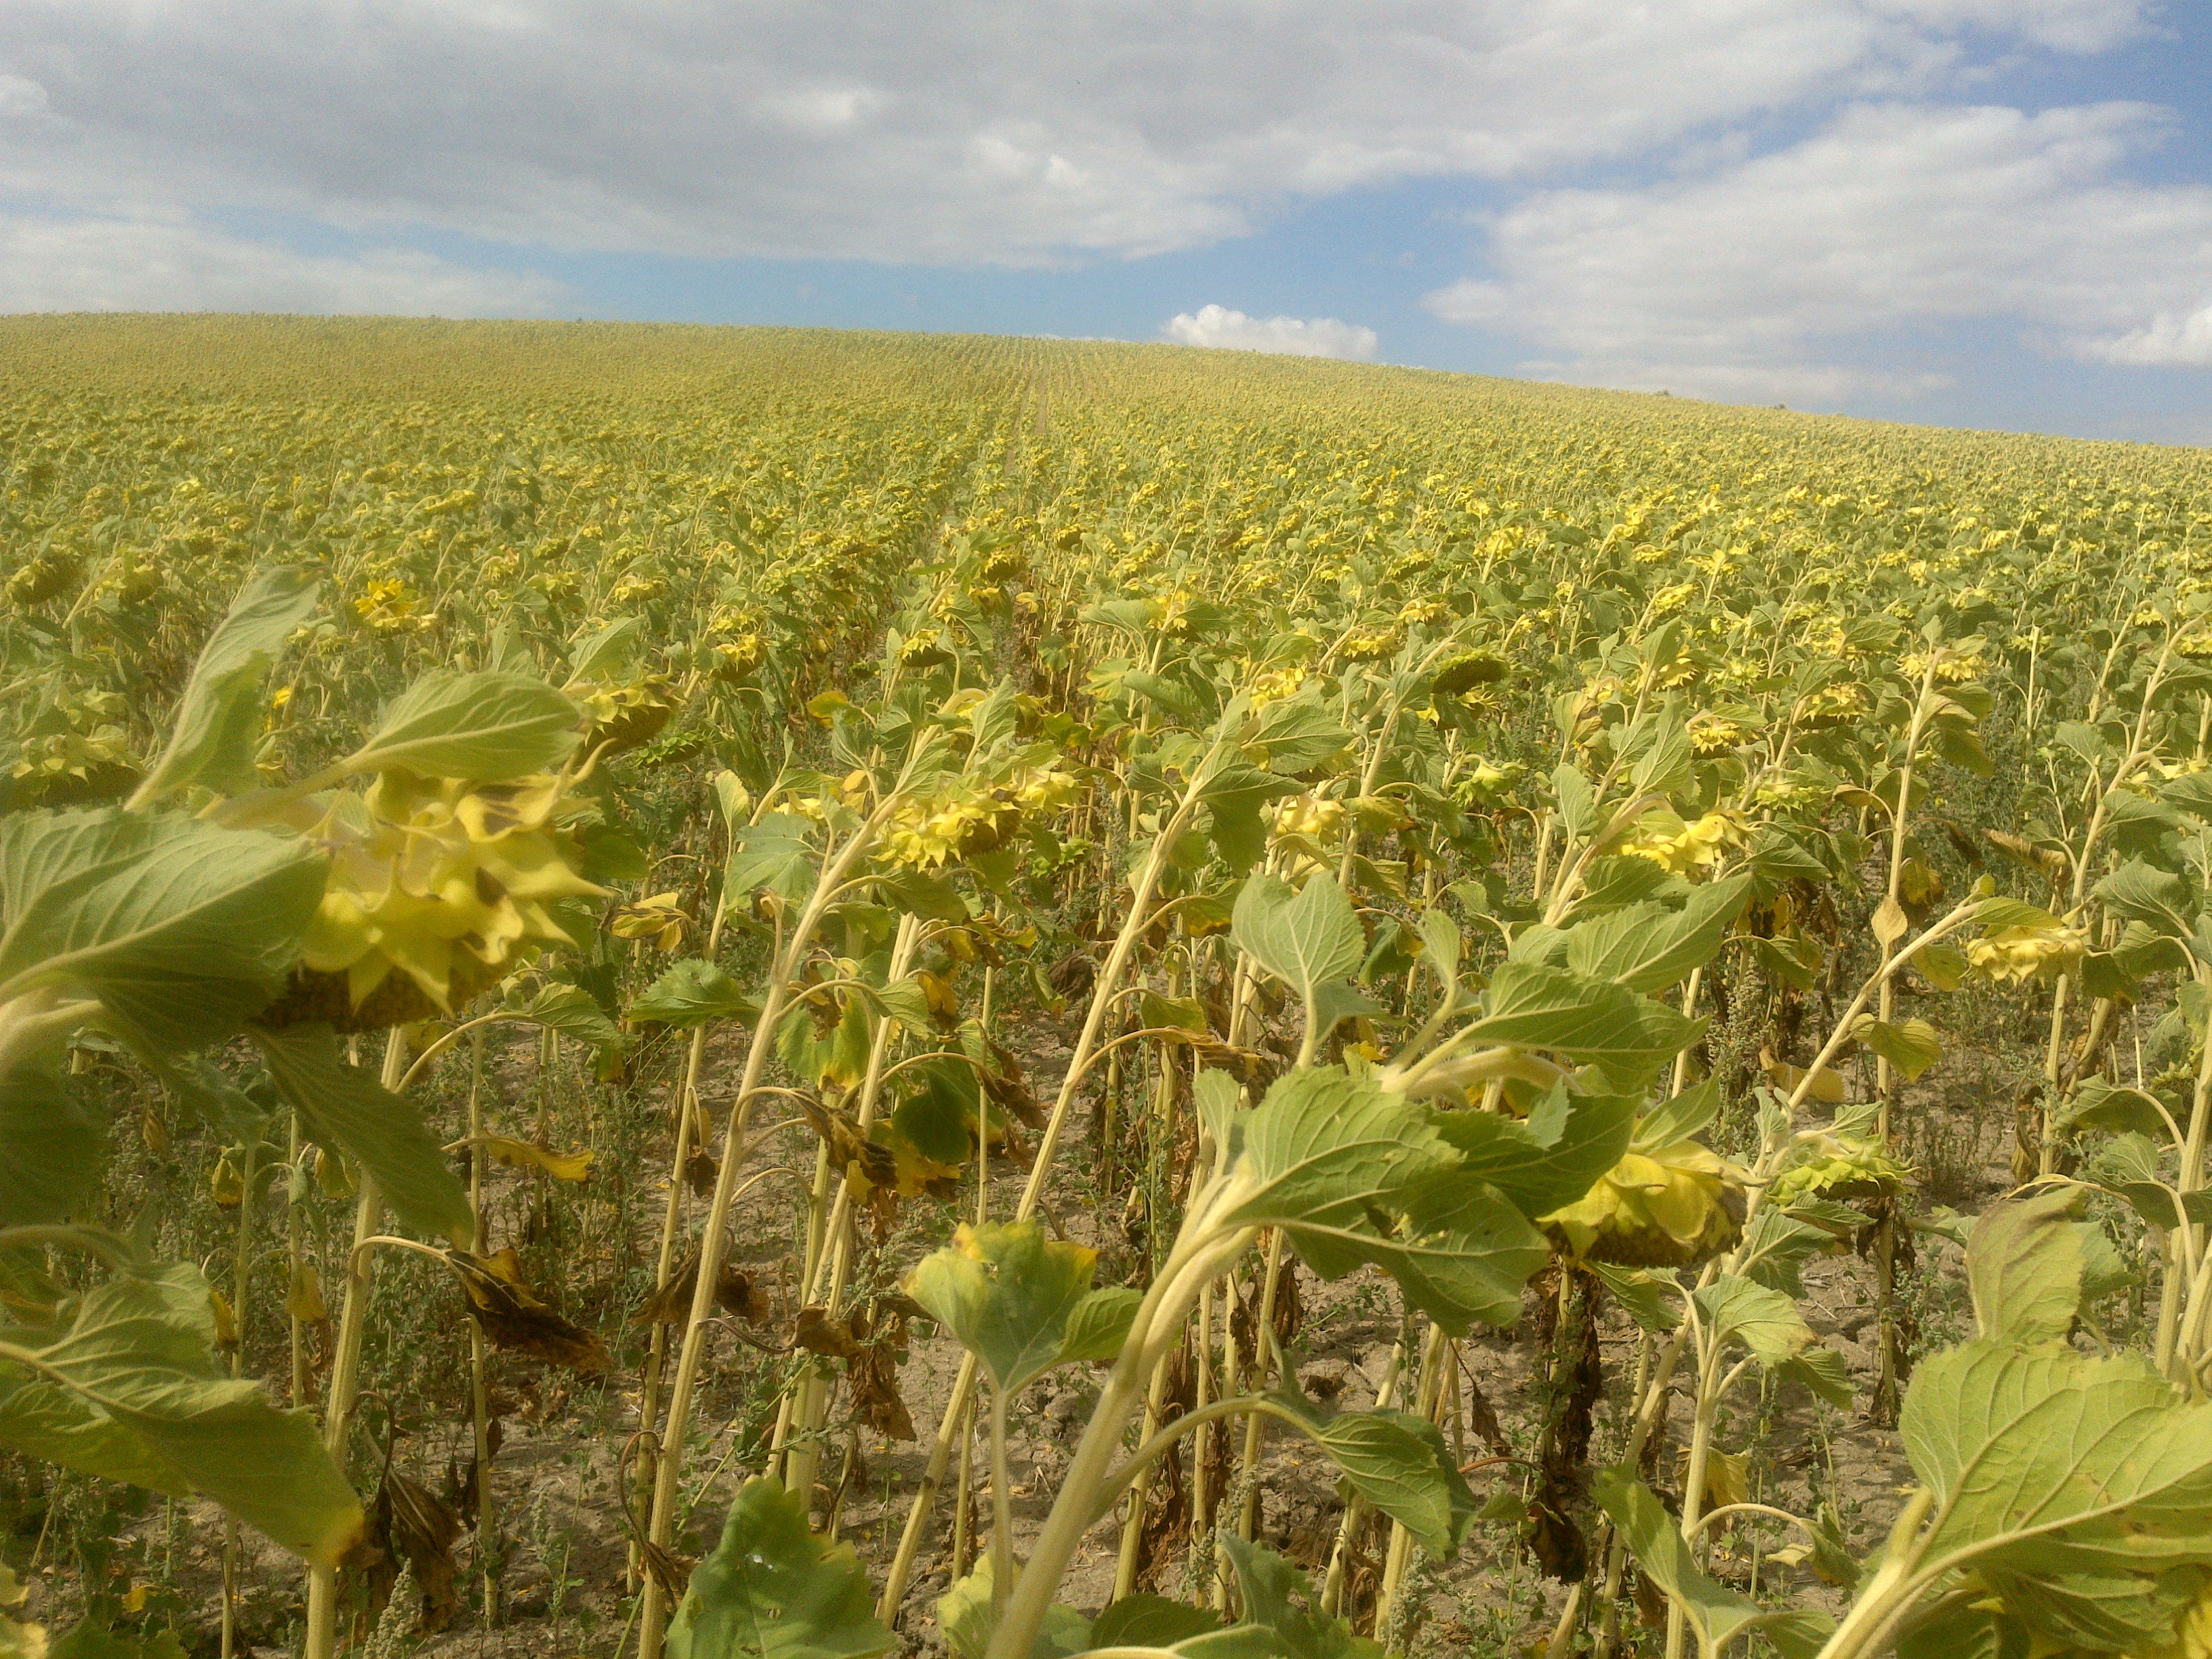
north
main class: Cropland
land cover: Sunflower
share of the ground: > 75 %
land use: Agriculture (excluding fallow land and kitchen gardens)
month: June
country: ES
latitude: 37.8009
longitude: -4.5358
